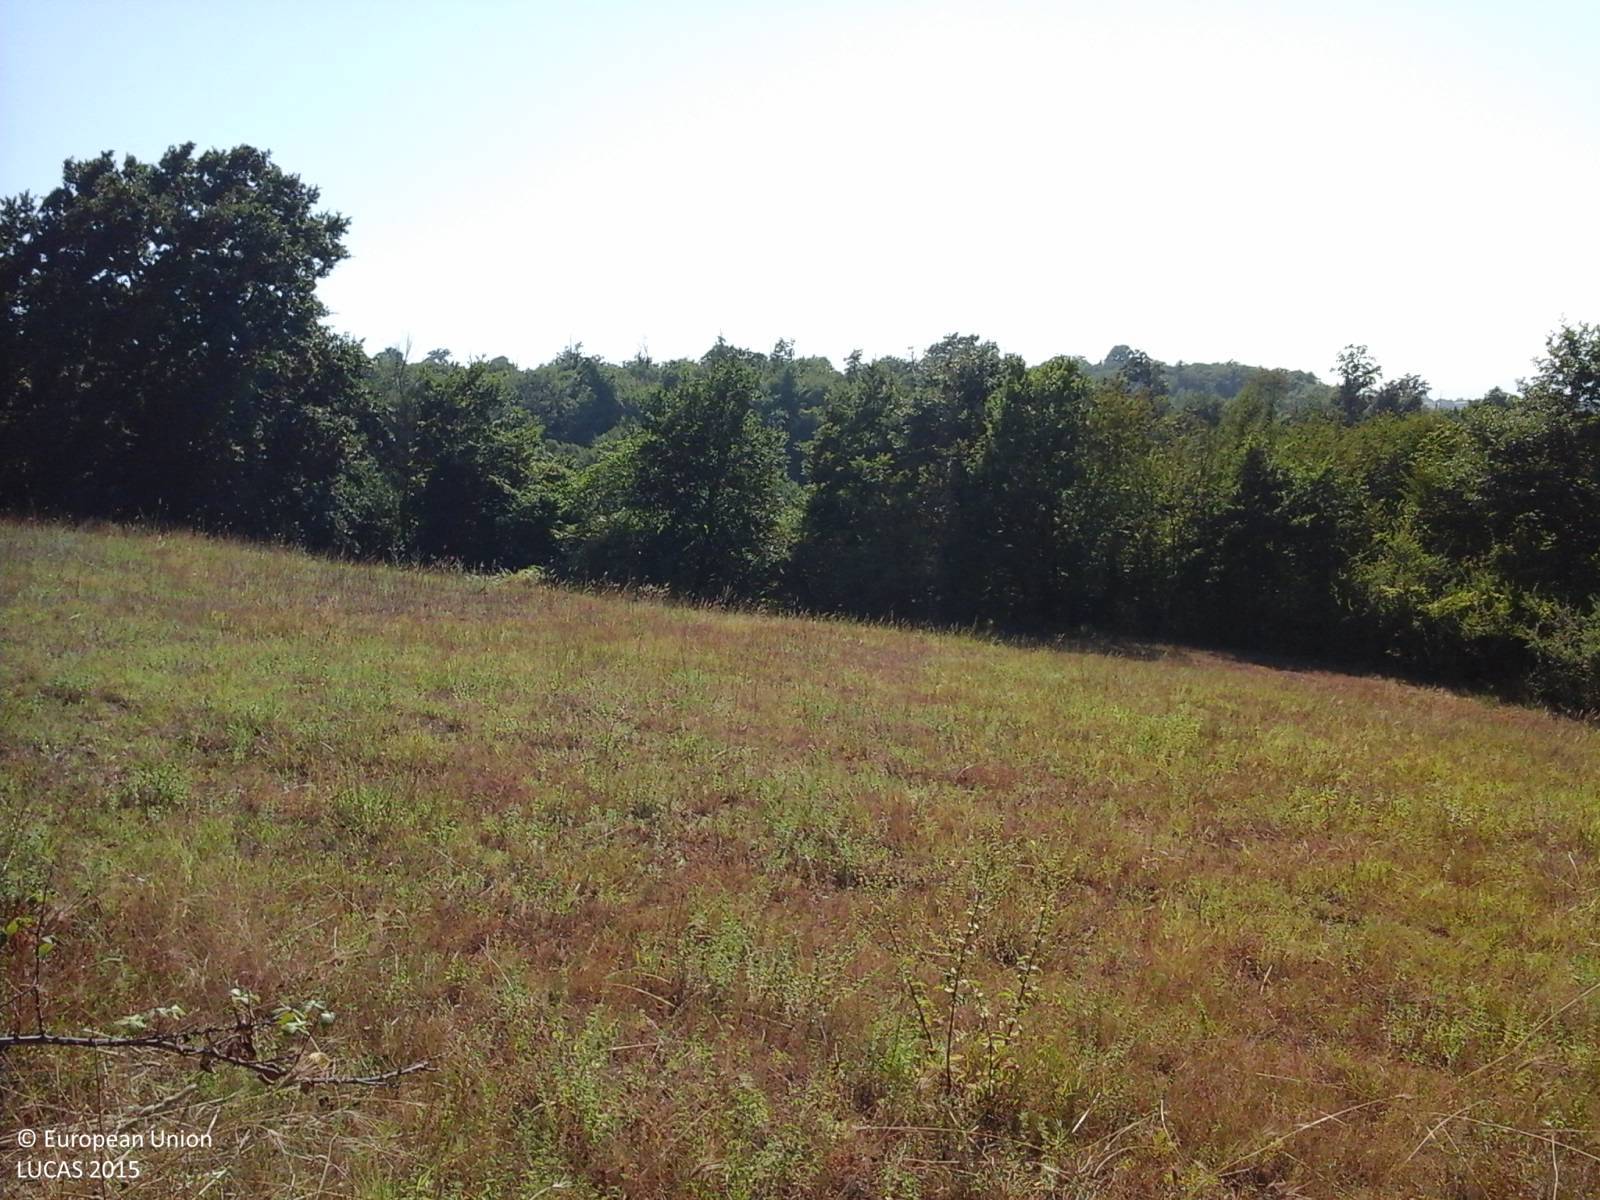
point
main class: Woodland
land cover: Broadleaved woodland
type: thermophilous deciduous forest
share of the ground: > 75 %
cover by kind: broadleaved forest trees 85 %, shrubs 15 %
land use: Semi-natural and natural areas not in use
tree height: > 5 m
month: July
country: IT
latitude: 42.1377
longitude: 12.3991
